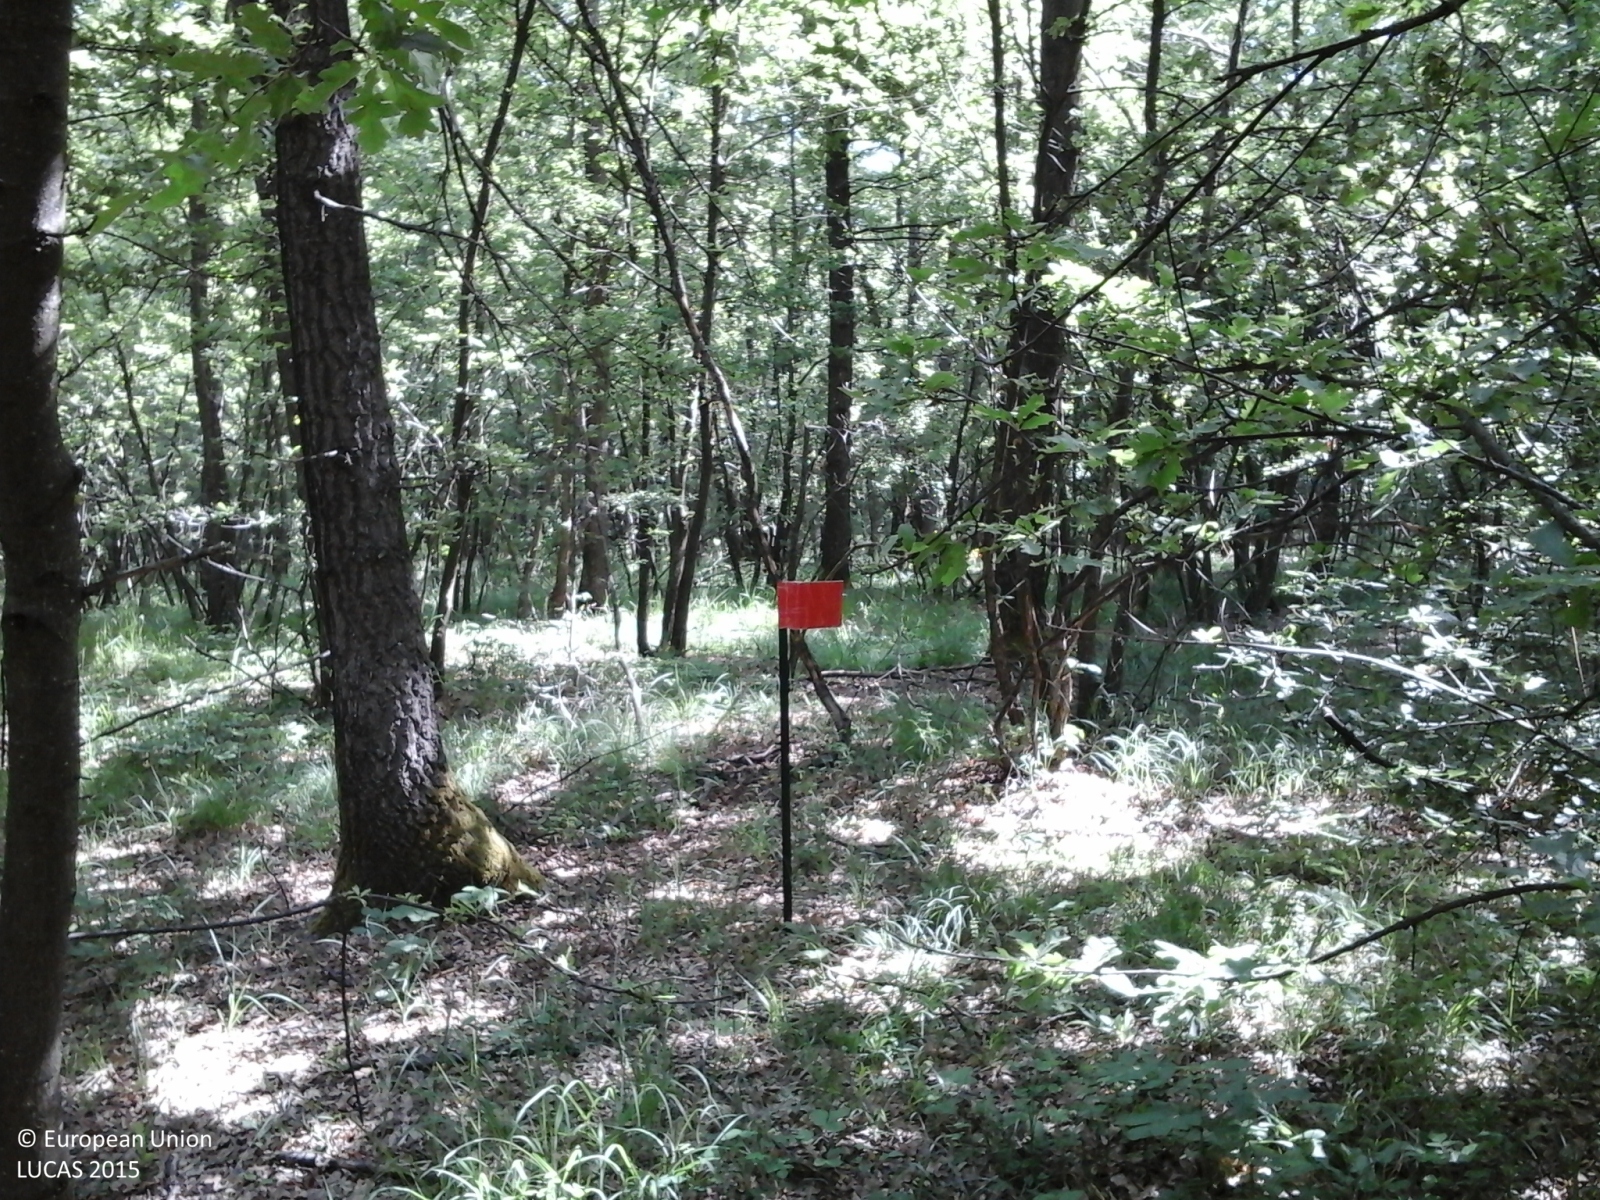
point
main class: Woodland
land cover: Broadleaved woodland
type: thermophilous deciduous forest
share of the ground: > 75 %
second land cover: Grassland without tree/shrub cover
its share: 50 - 75 %
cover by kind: broadleaved forest trees 100 %
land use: Forestry
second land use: Agriculture (excluding fallow land and kitchen gardens)
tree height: > 5 m
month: May
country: IT
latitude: 44.4202
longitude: 10.7143
